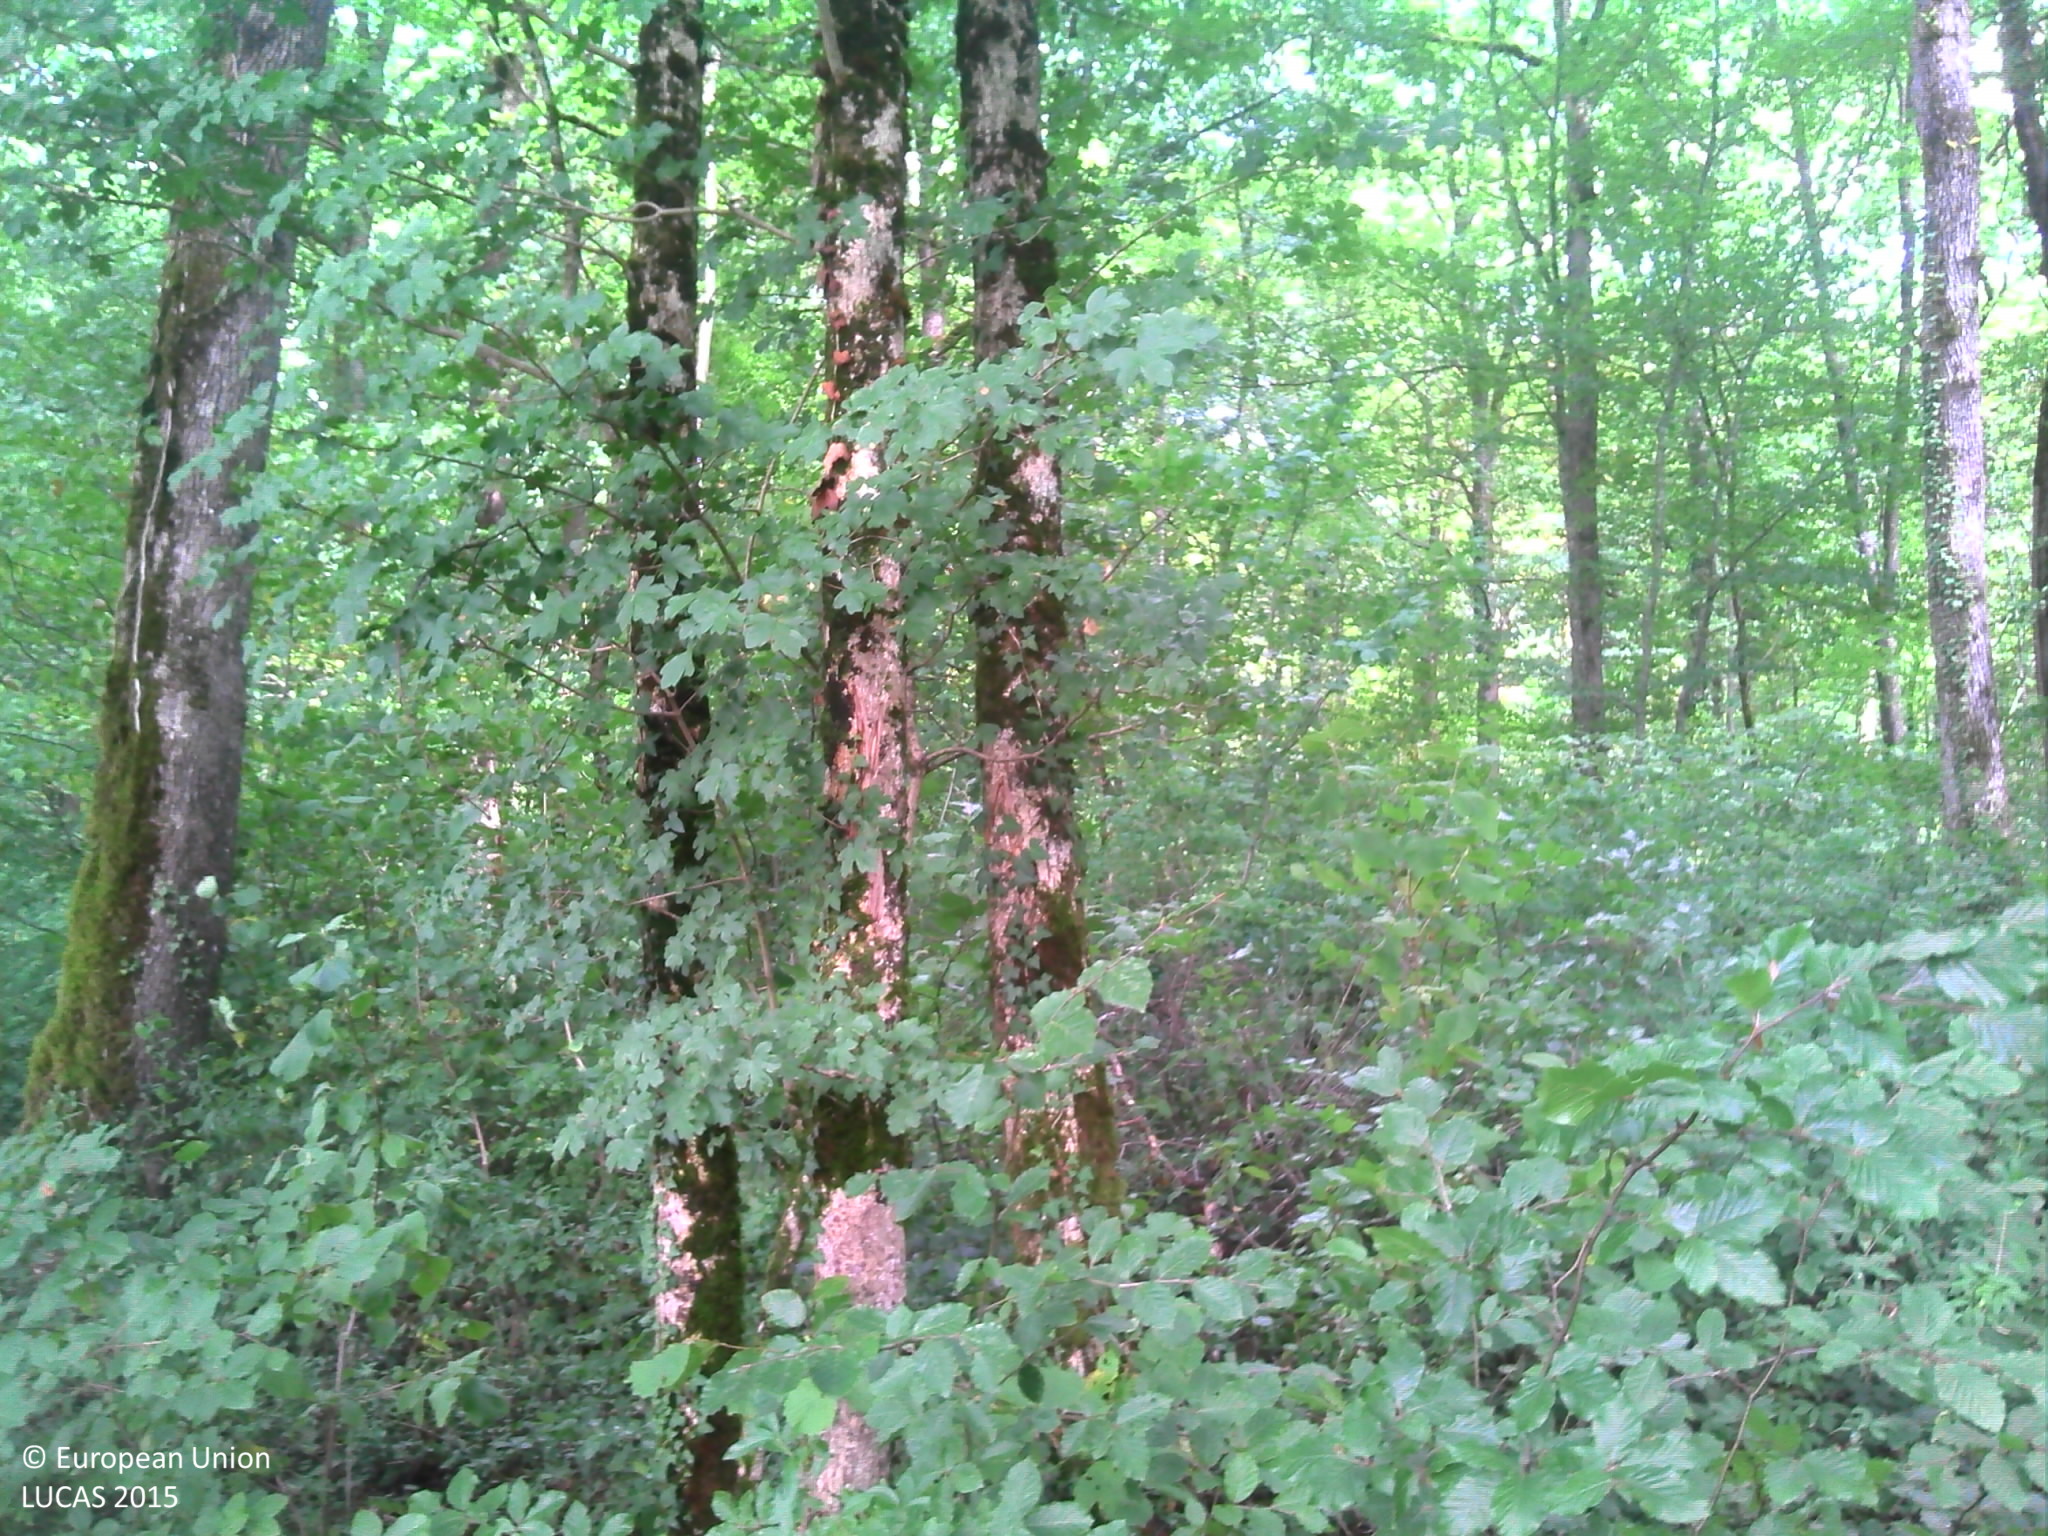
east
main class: Woodland
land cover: Broadleaved woodland
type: mesophytic deciduous forest
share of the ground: > 75 %
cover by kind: broadleaved forest trees 75 %, herbaceous plants 20 %, lichens and mosses 5 %
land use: Forestry
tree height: > 5 m
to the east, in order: Broadleaved woodland; Tracks; Broadleaved woodland; Tracks; Broadleaved woodland
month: August
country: FR
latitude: 47.7327
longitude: 5.0261
